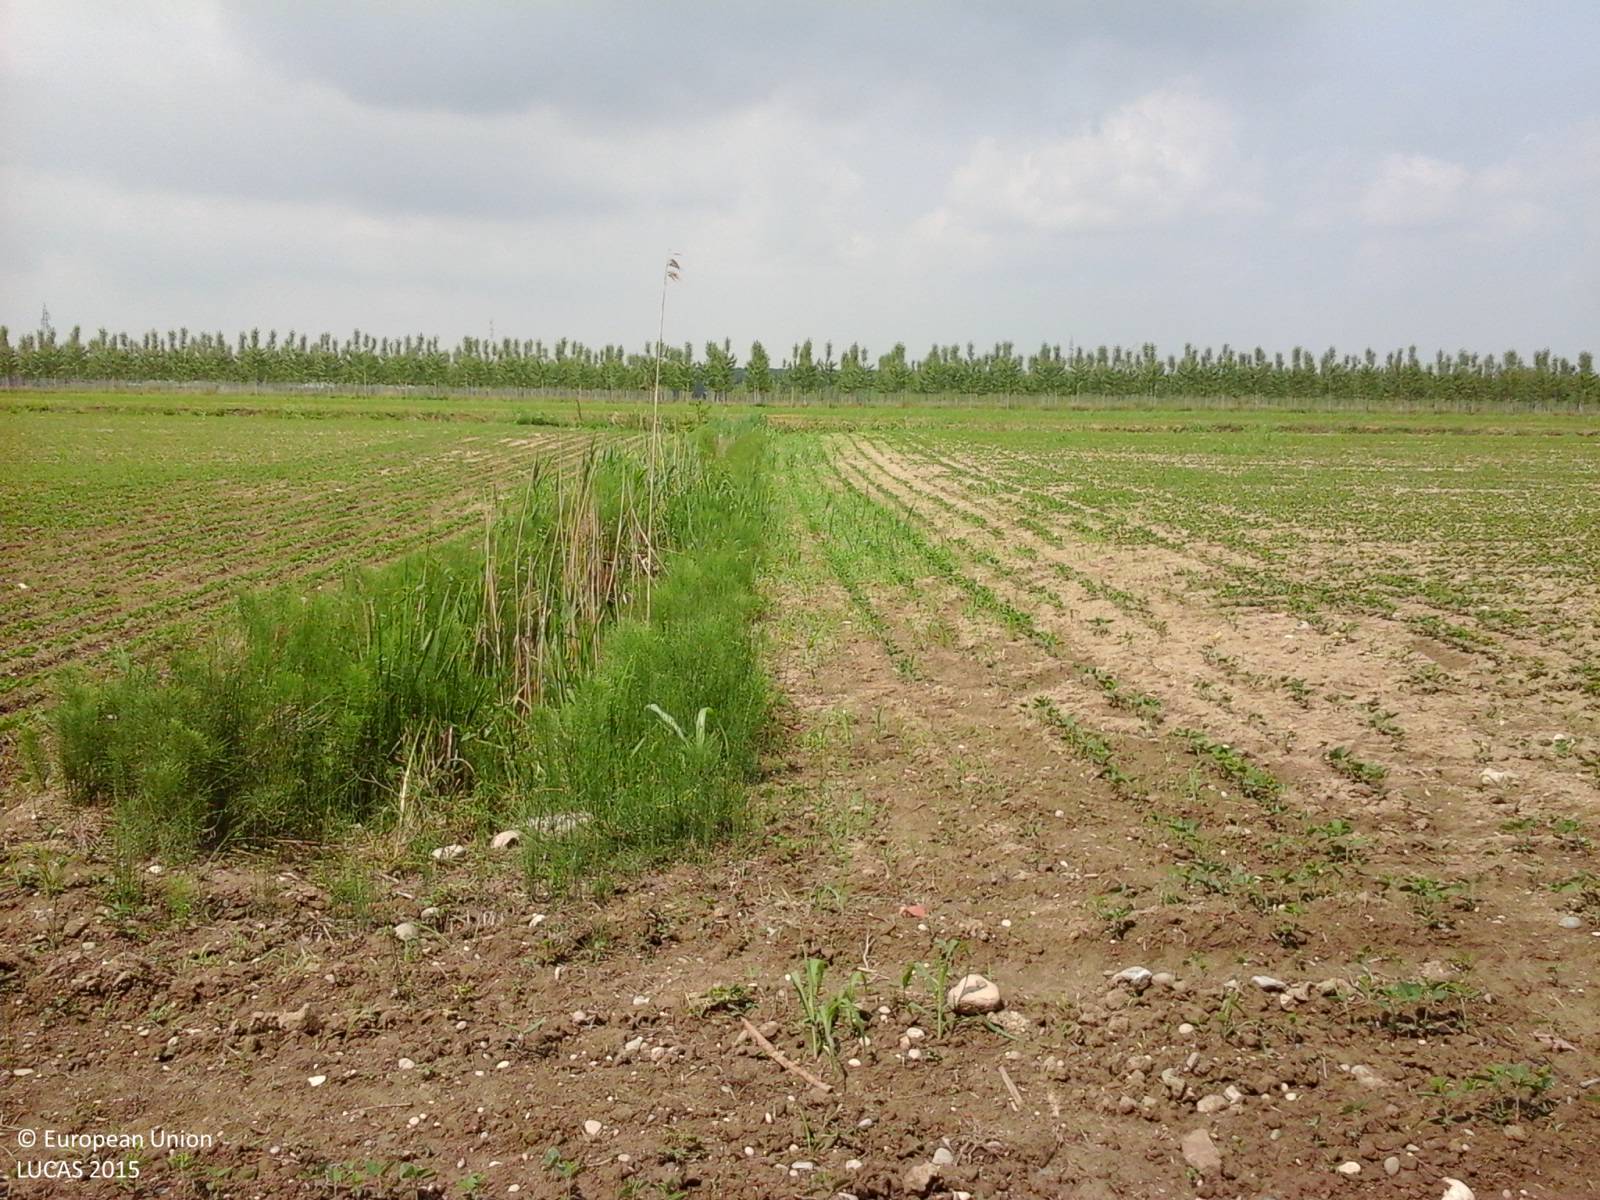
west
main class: Woodland
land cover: Broadleaved woodland
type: thermophilous deciduous forest
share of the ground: > 75 %
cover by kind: broadleaved forest trees 90 %, shrubs 10 %
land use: Forestry
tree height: > 5 m
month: May
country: IT
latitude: 45.8682
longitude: 13.2810
